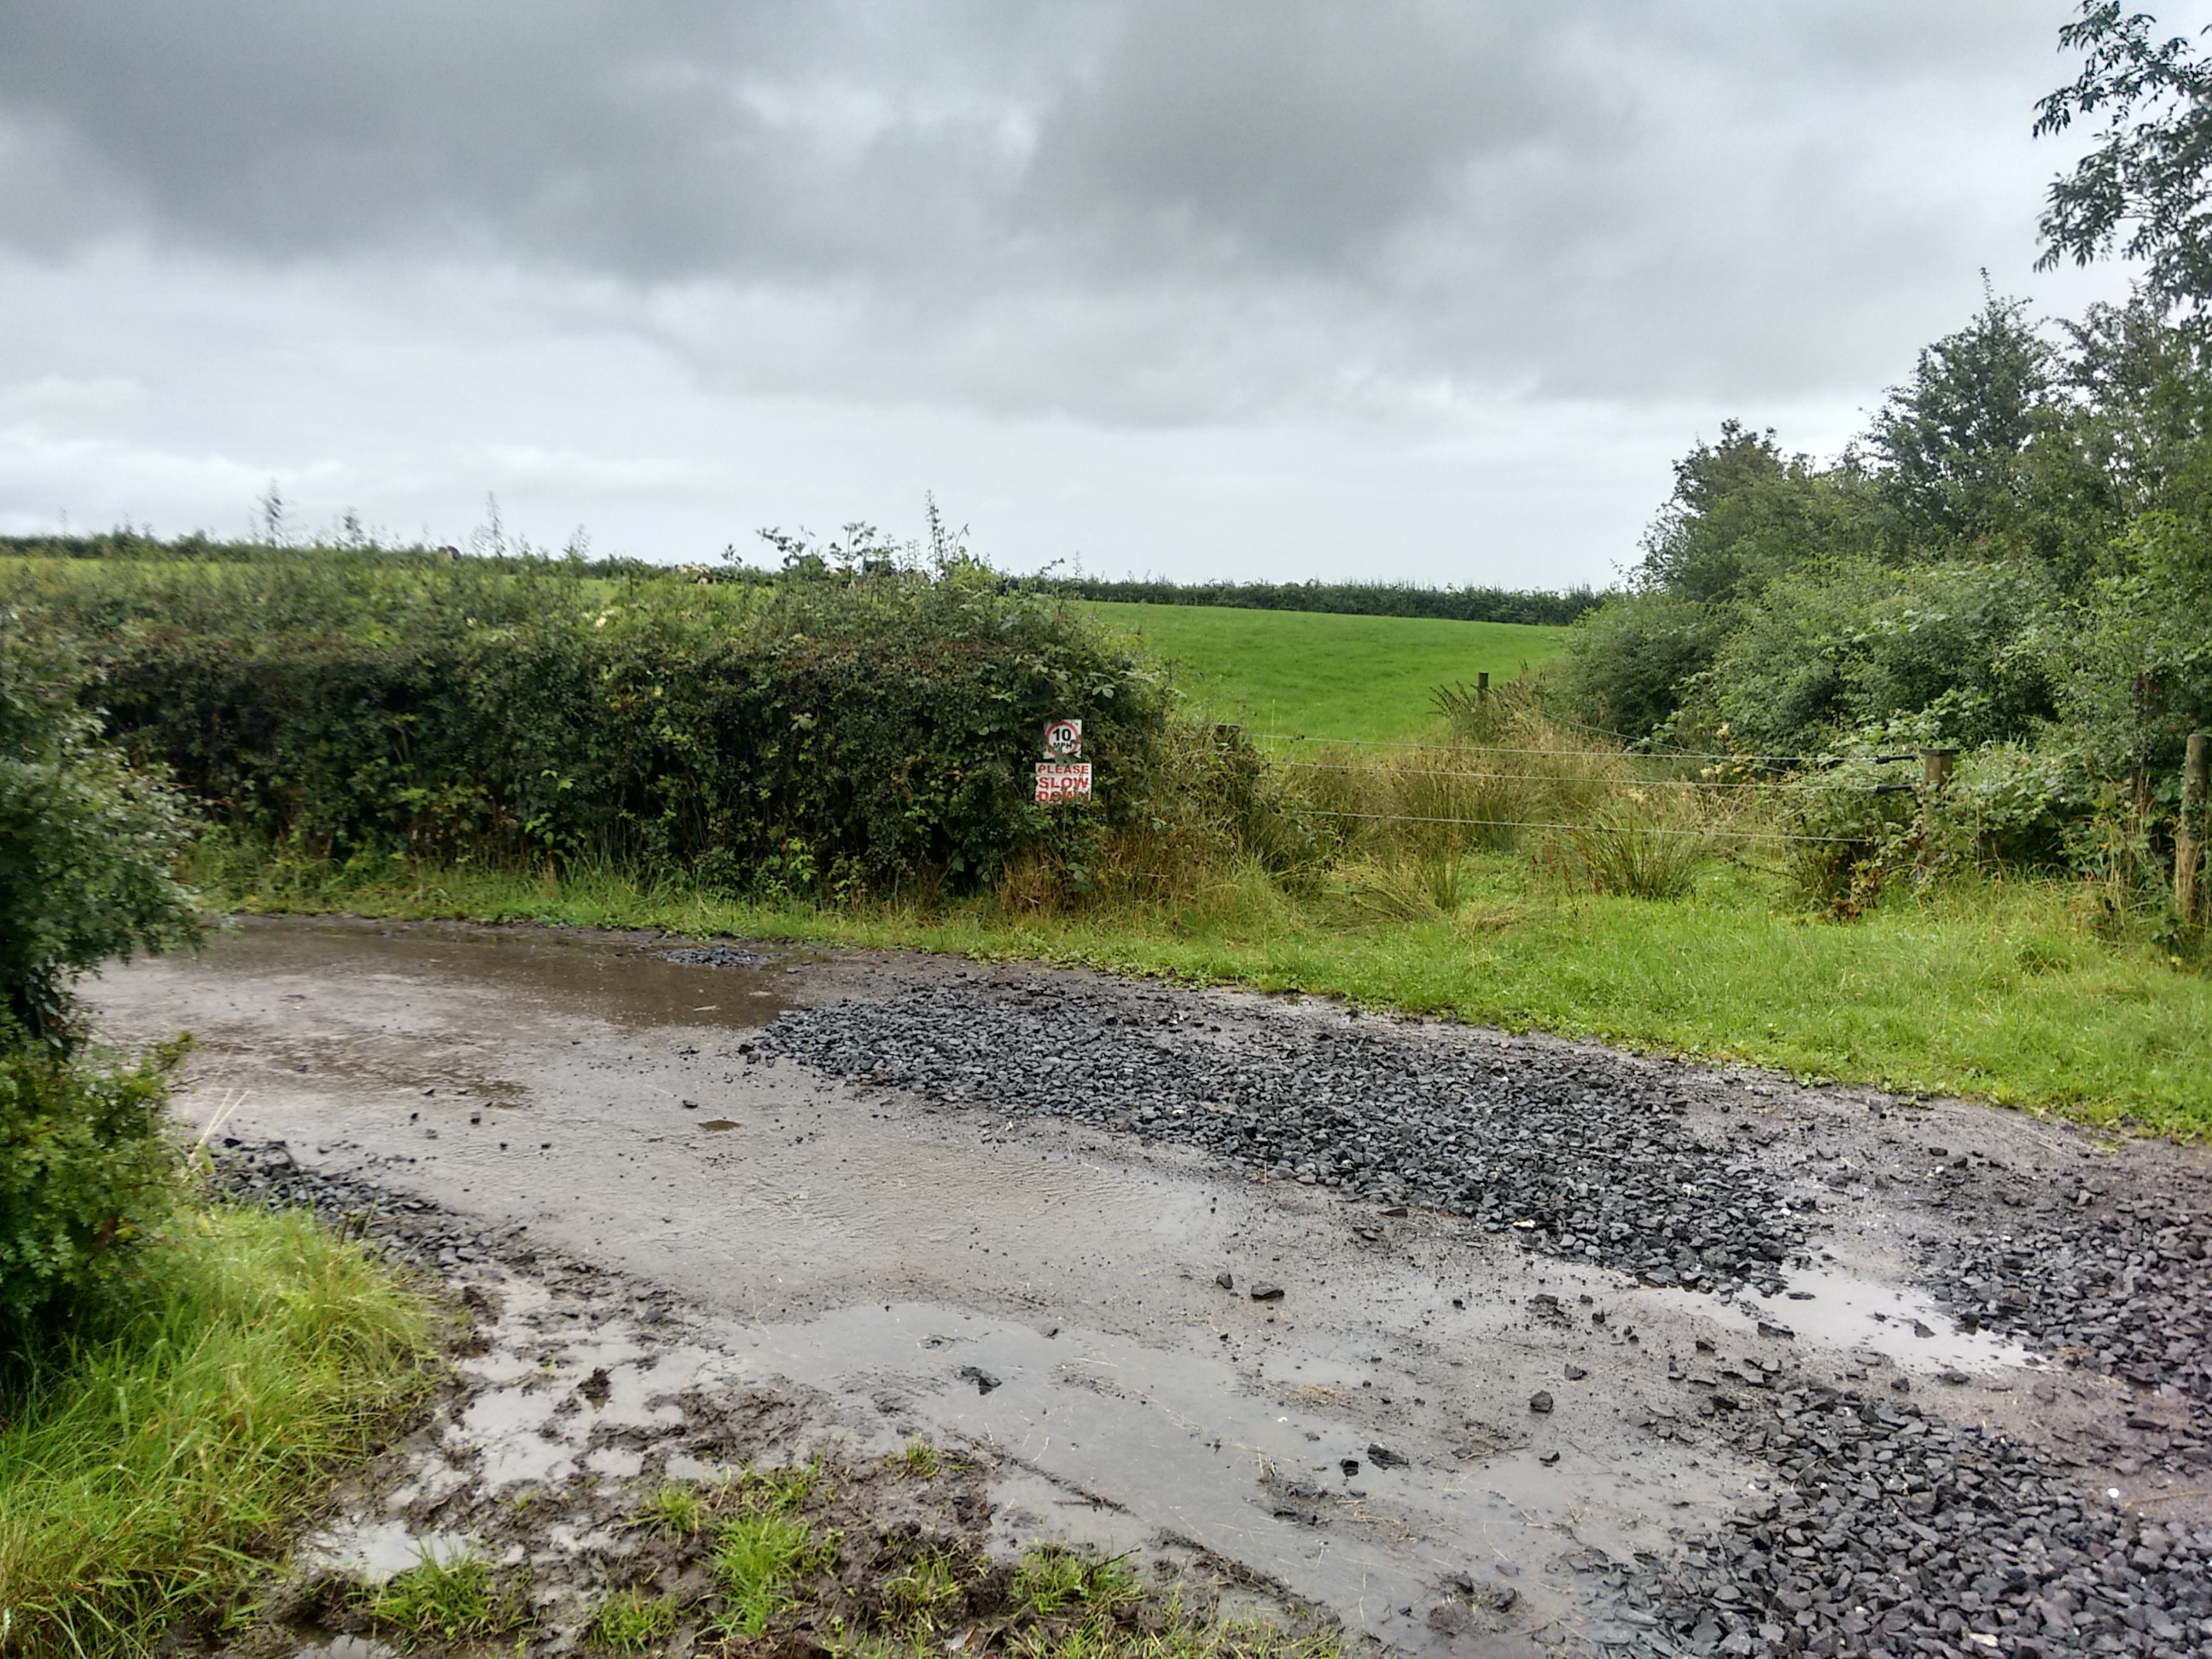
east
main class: Grassland
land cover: Grassland without tree/shrub cover
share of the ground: > 75 %
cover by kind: herbaceous plants 100 %
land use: Agriculture (excluding fallow land and kitchen gardens)
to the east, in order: Grassland without tree/shrub cover; Electric lines; Fences; Abandoned hedges; Tracks; Grass margins; Abandoned hedges; Fences; Grassland without tree/shrub cover; Fences; Abandoned hedges; Grassland without tree/shrub cover; Fences; Abandoned hedges; Grassland without tree/shrub cover
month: August
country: GB
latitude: 54.8353
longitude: -6.6144
